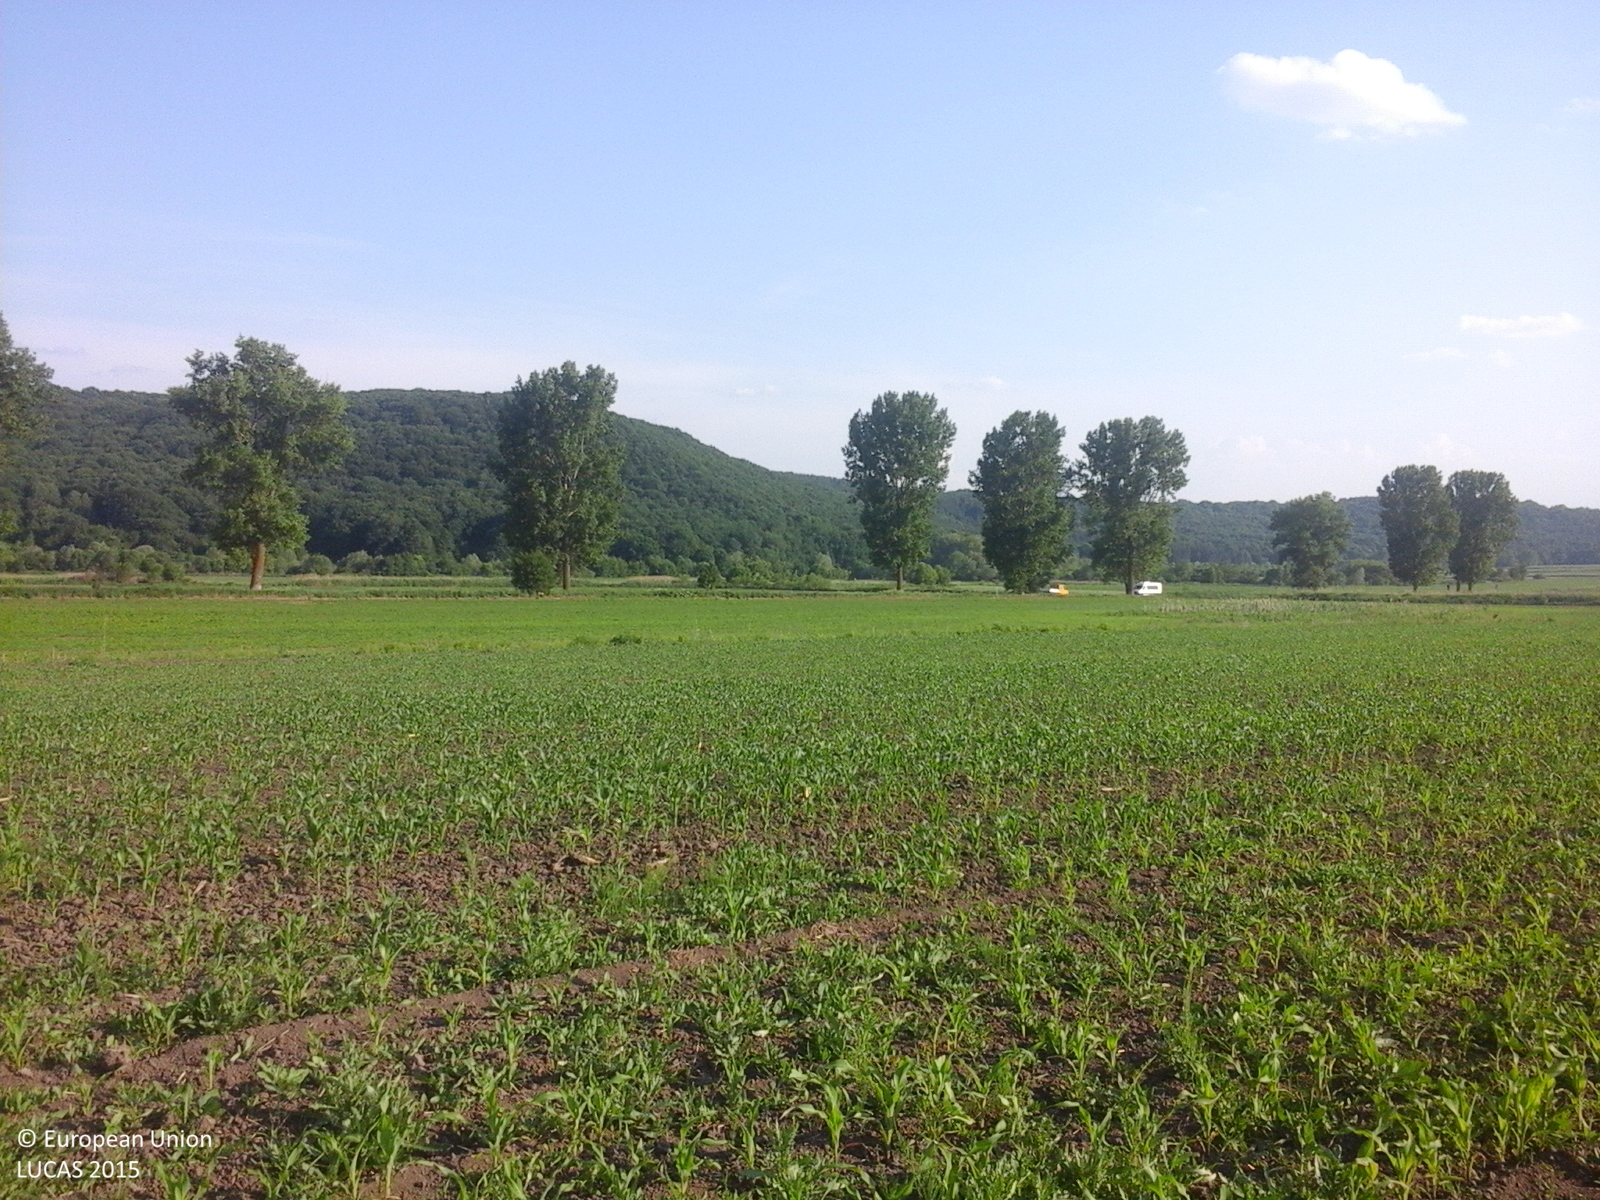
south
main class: Cropland
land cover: Maize
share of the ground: 10 - 25 %
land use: Agriculture (excluding fallow land and kitchen gardens)
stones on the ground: < 10 %
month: June
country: RO
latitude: 46.9673
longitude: 26.7445
